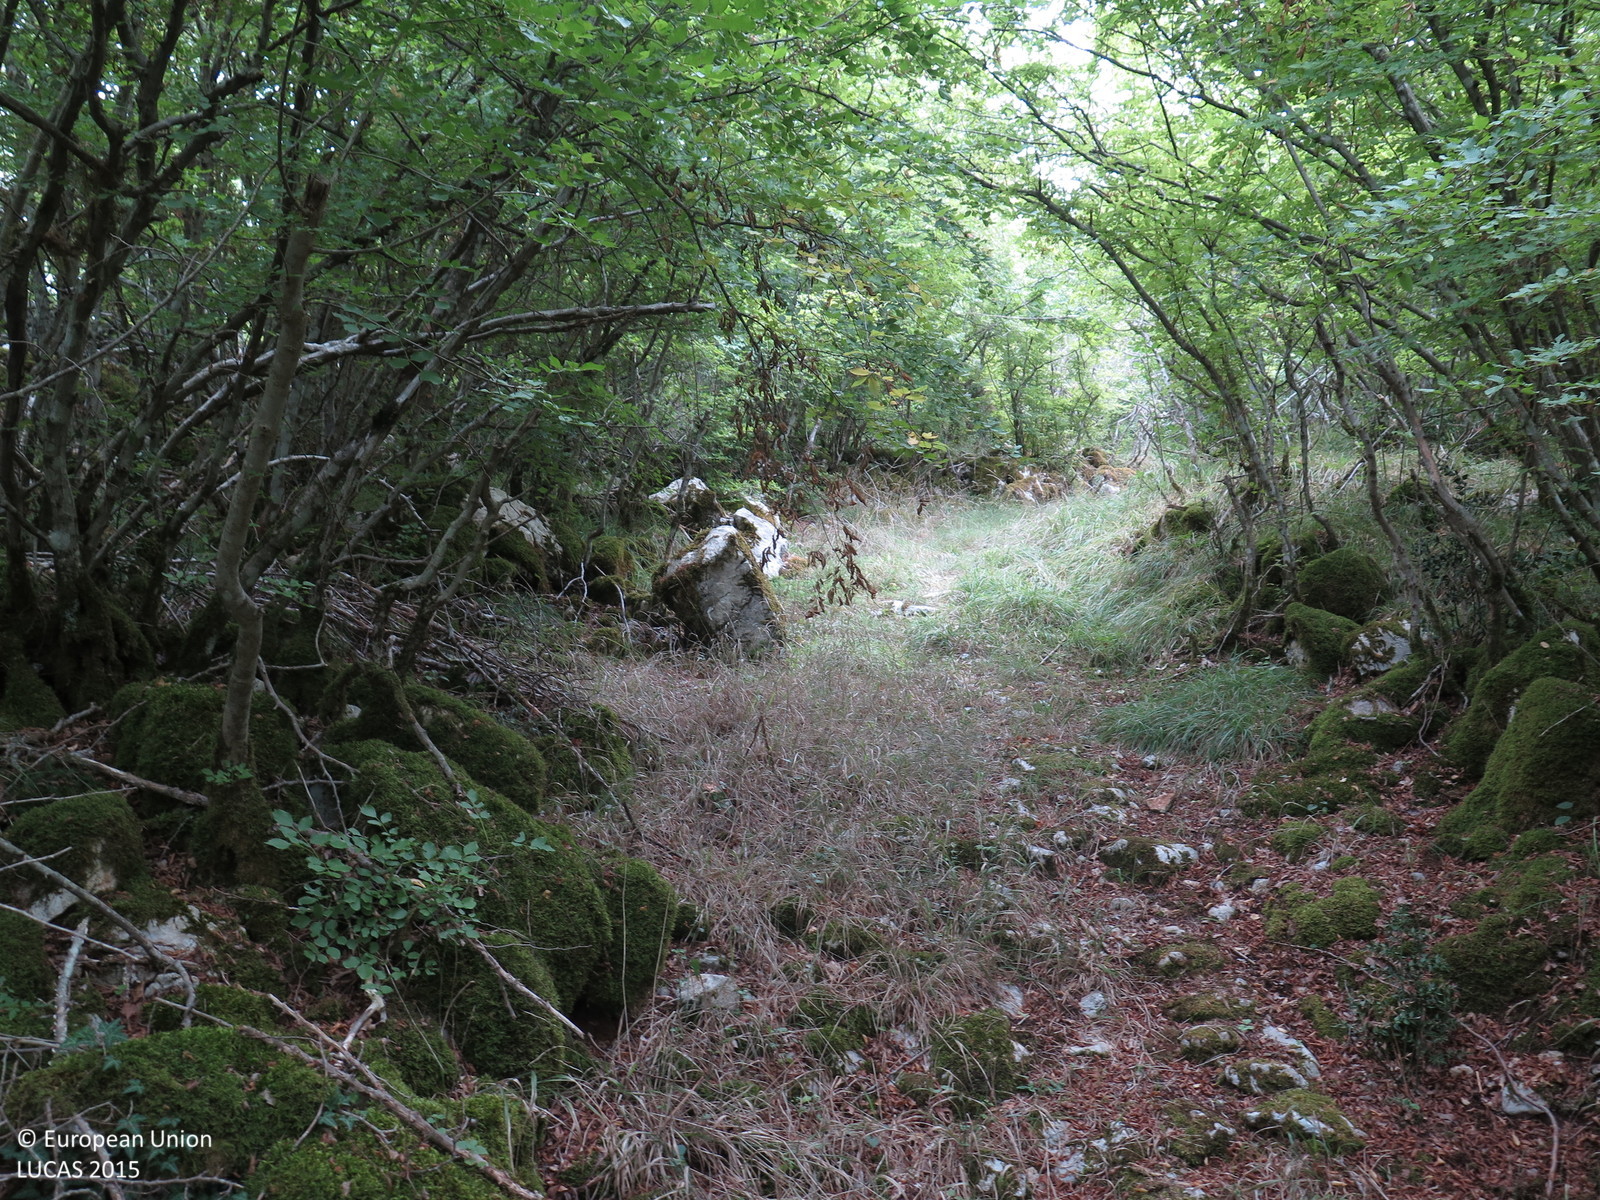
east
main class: Woodland
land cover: Broadleaved woodland
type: thermophilous deciduous forest
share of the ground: > 75 %
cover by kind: broadleaved forest trees 90 %, lichens and mosses 5 %, unconsolidated bare surface 5 %
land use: Semi-natural and natural areas not in use
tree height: < 5 m
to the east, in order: Broadleaved woodland; Dry stone walls; Broadleaved woodland; Grassland with sparse tree/shrub cover; Broadleaved woodland
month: August
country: HR
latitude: 45.1161
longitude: 14.5834
